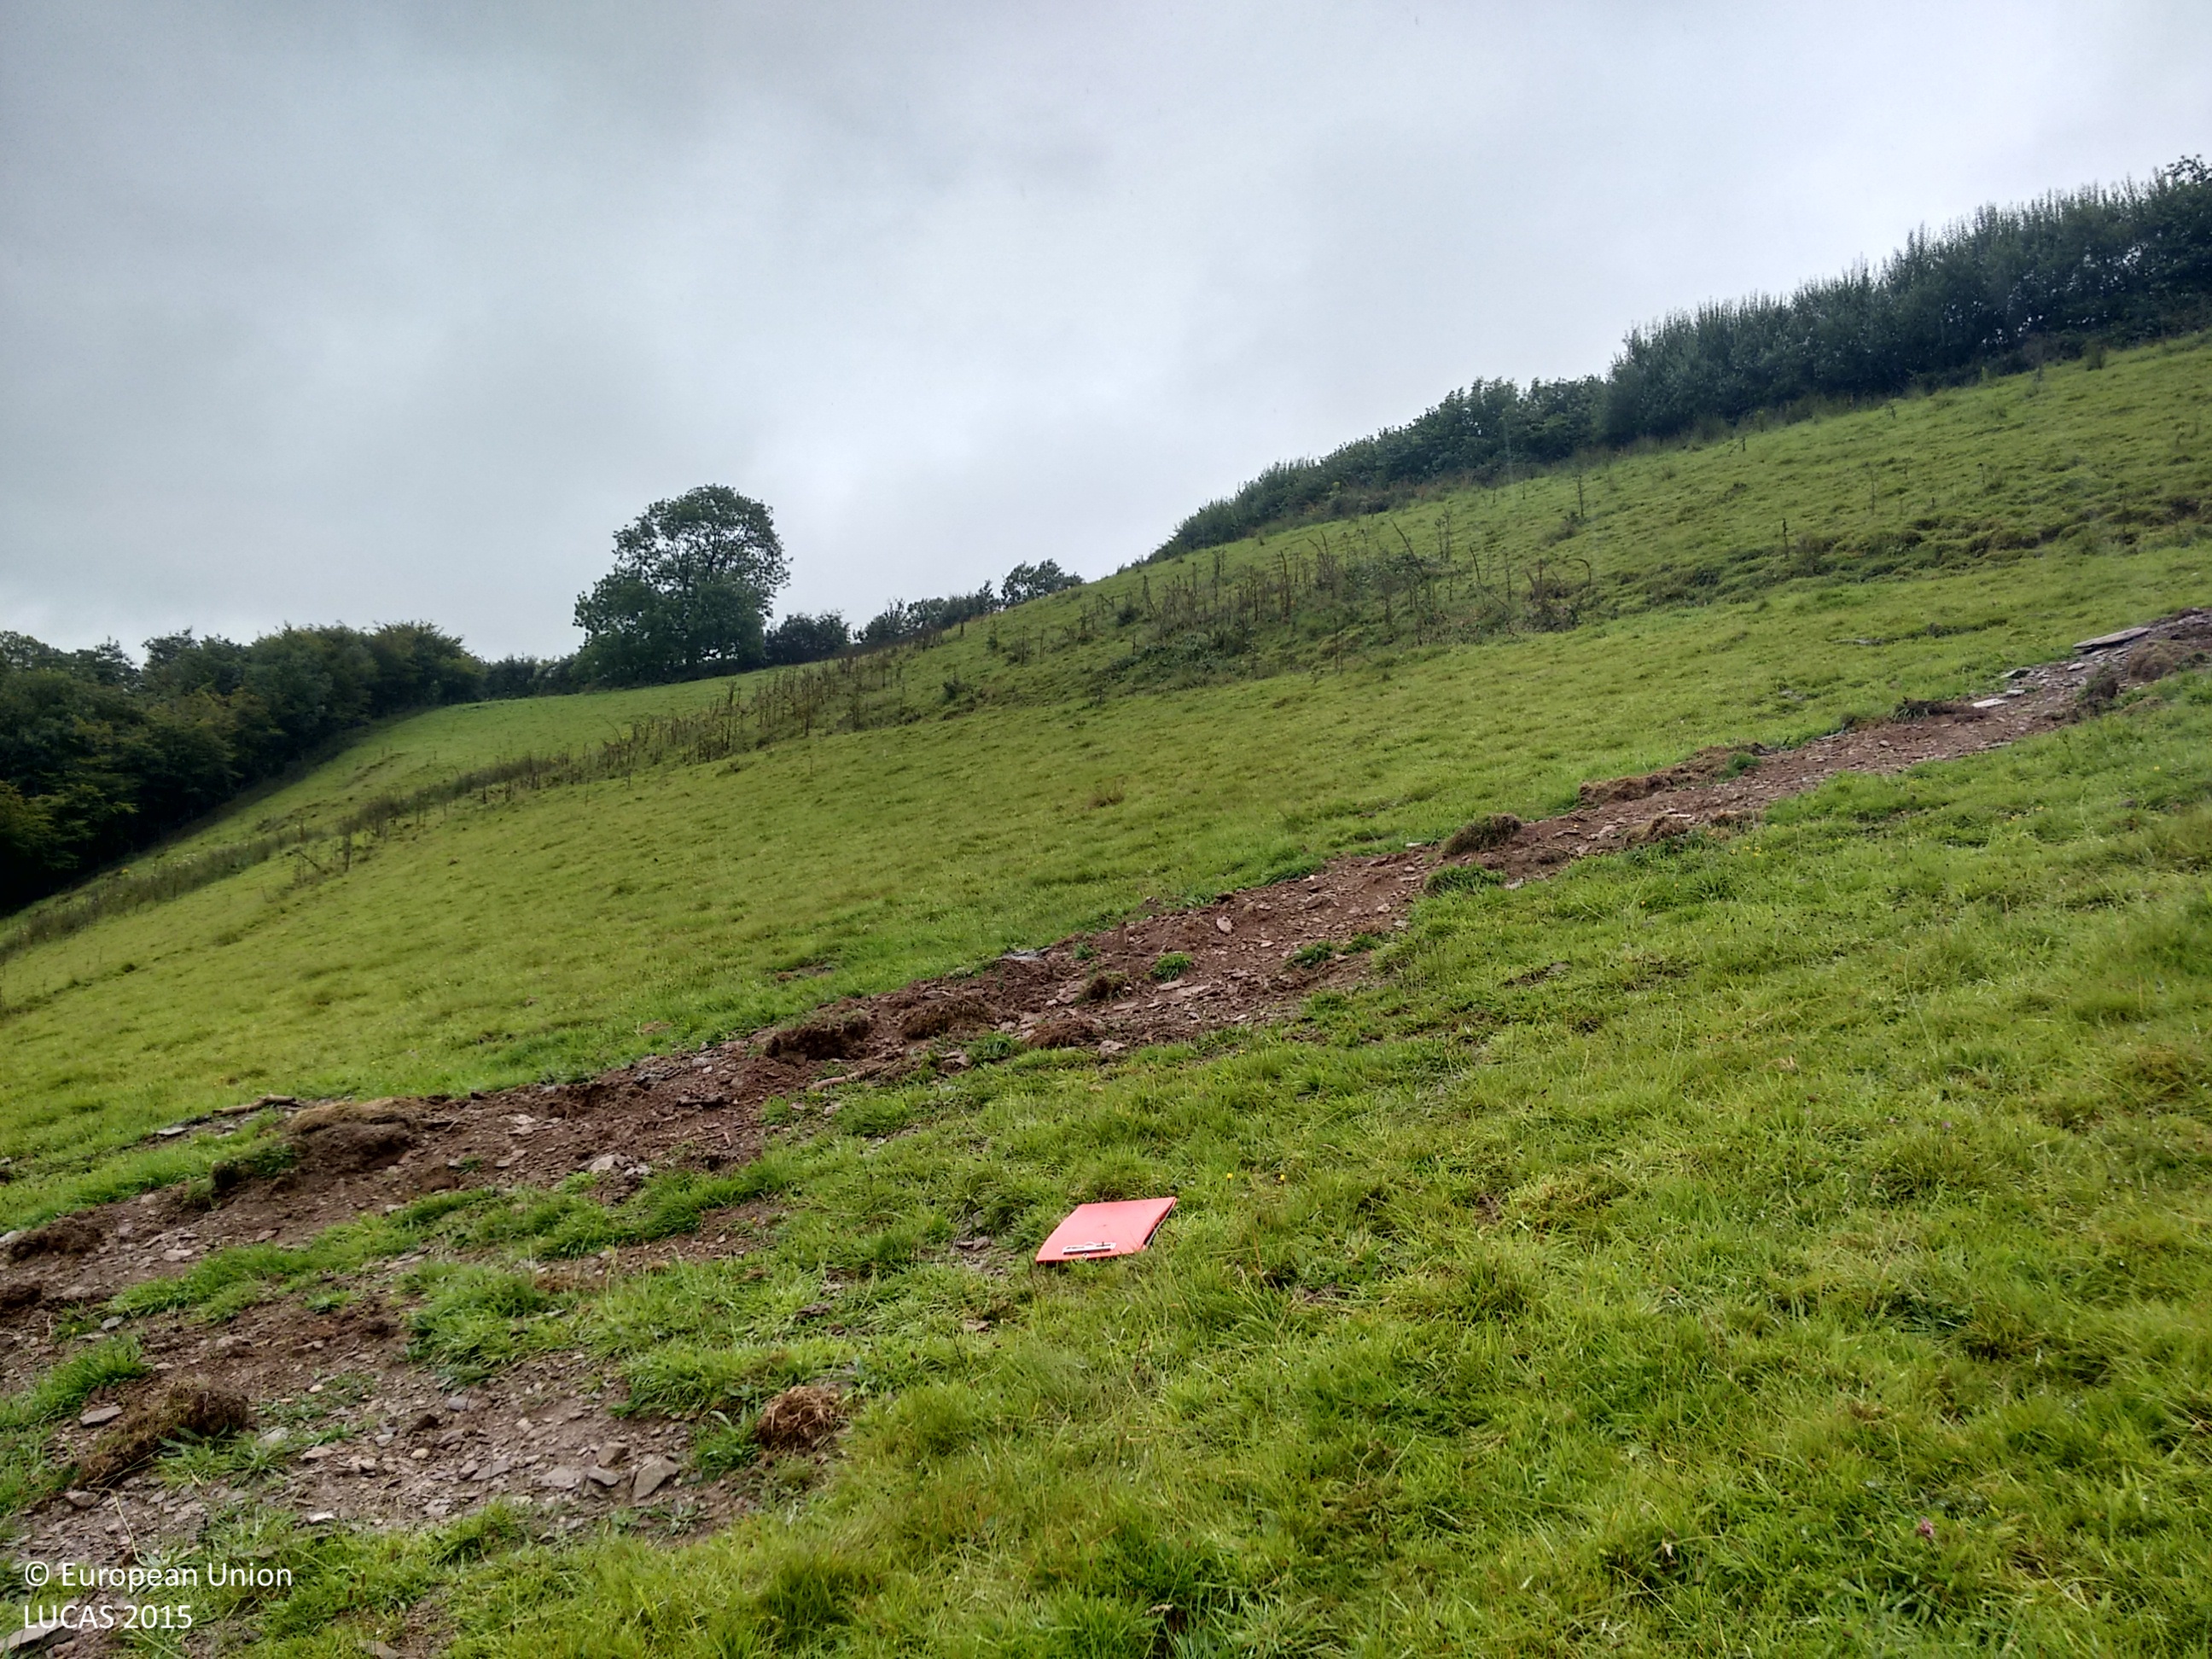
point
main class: Grassland
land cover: Grassland without tree/shrub cover
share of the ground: > 75 %
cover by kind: herbaceous plants 100 %
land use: Agriculture (excluding fallow land and kitchen gardens)
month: August
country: GB
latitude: 51.0854
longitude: -3.5474
